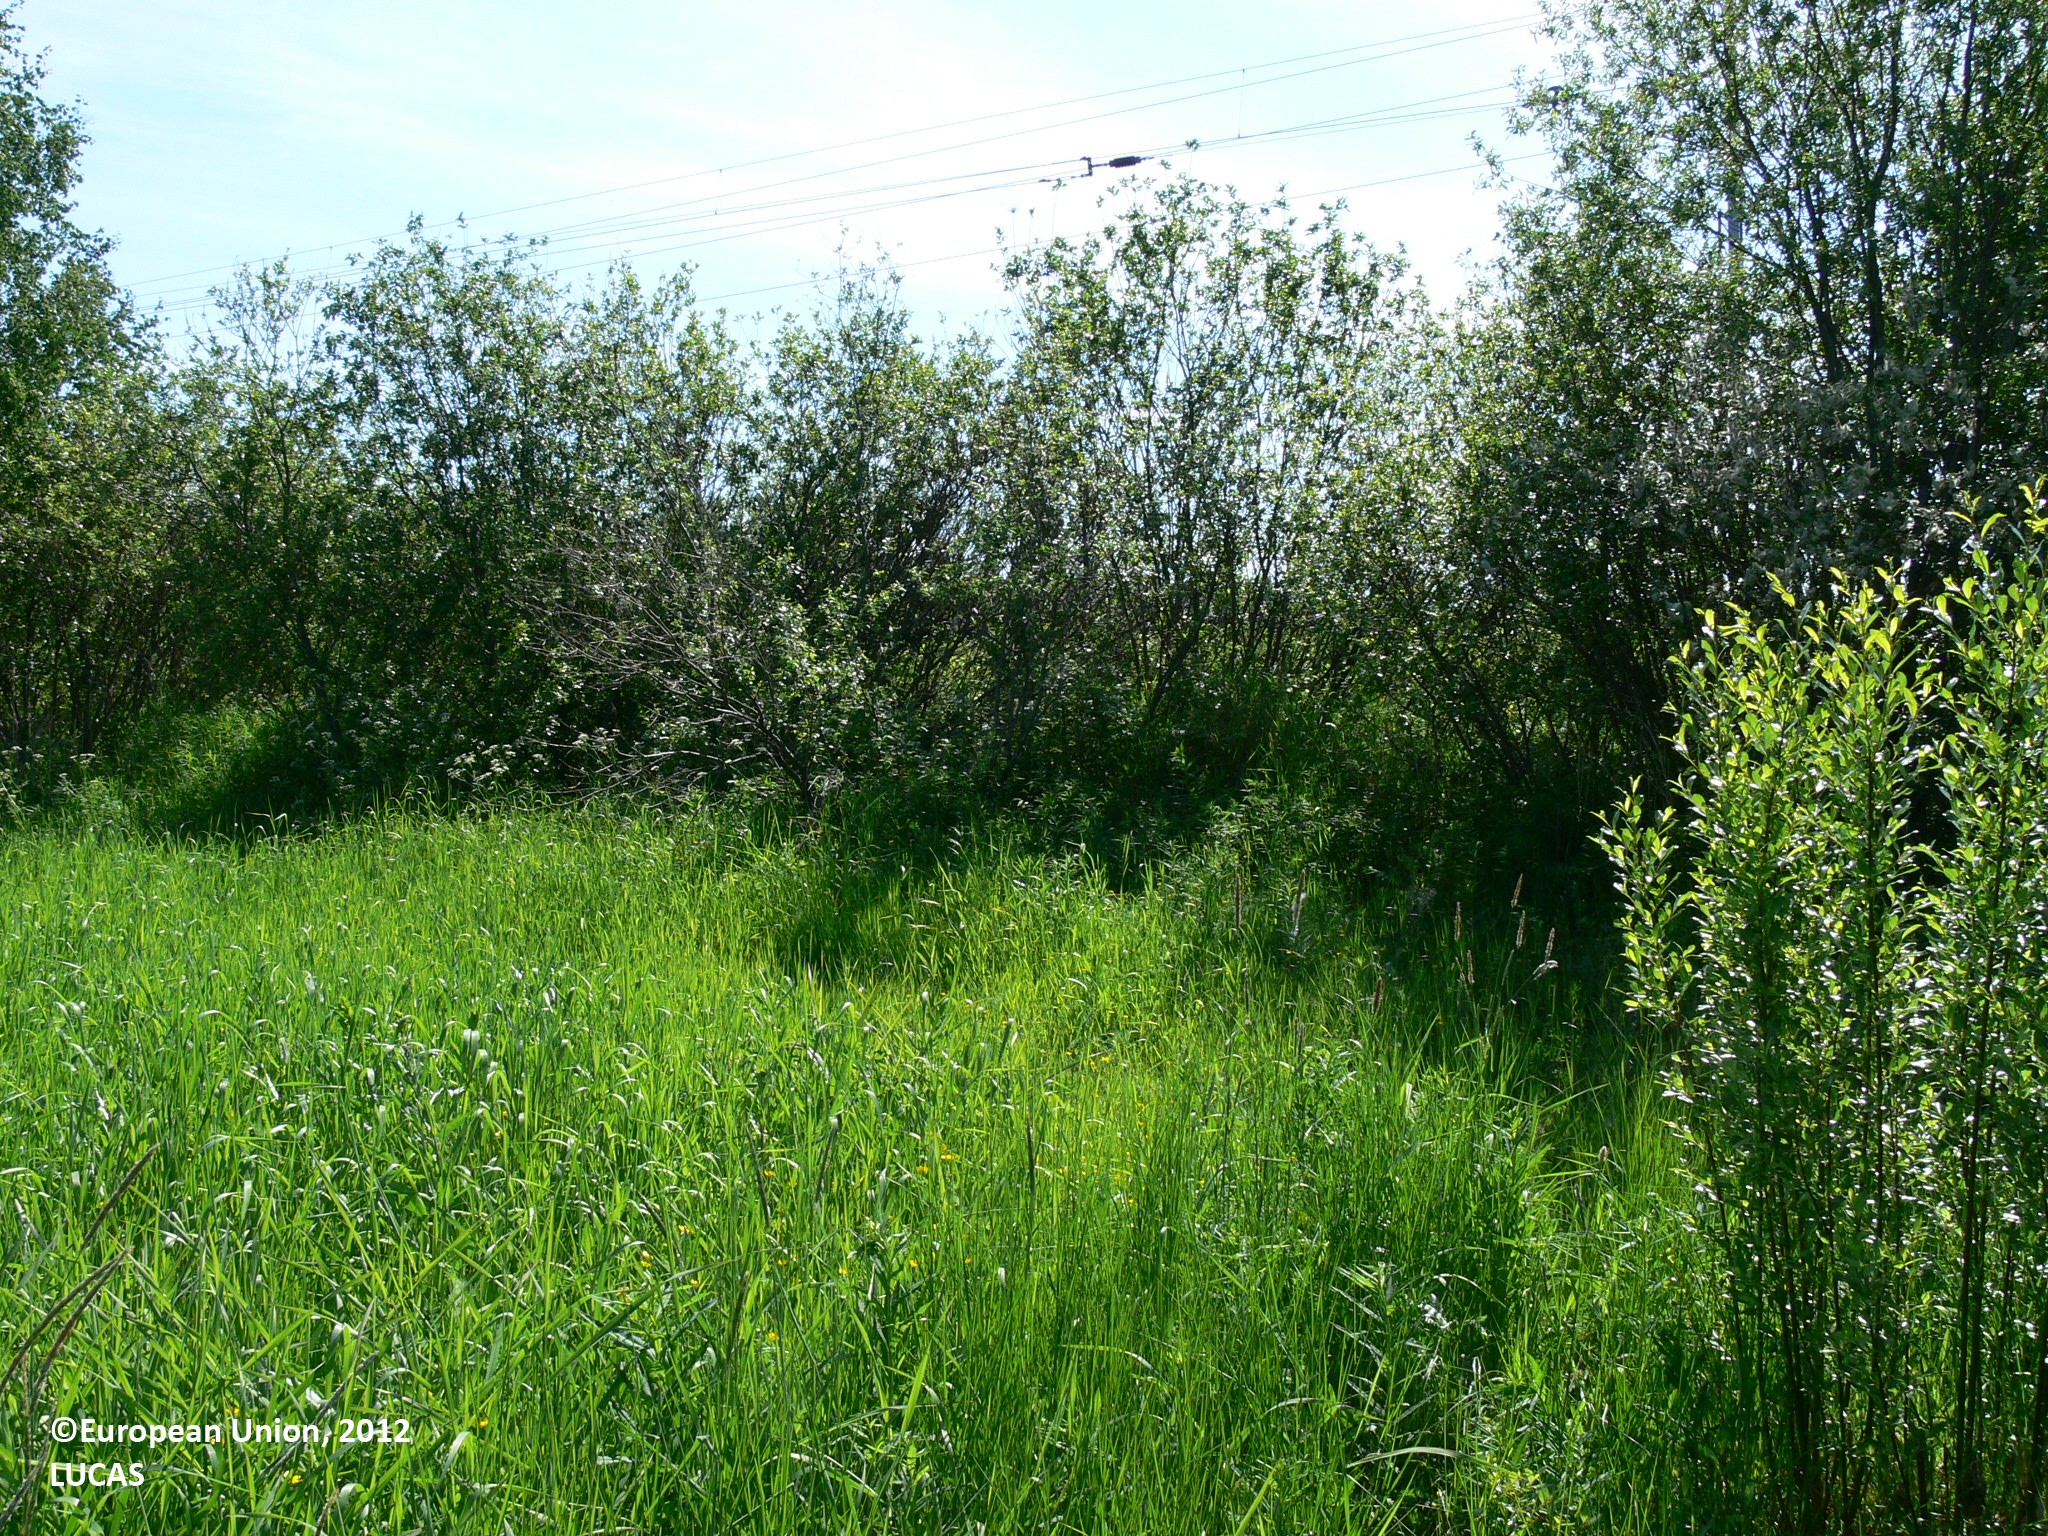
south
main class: Cropland
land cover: Temporary grasslands
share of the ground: > 75 %
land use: Agriculture (excluding fallow land and kitchen gardens)
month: June
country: FI
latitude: 62.5653
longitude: 29.8036
